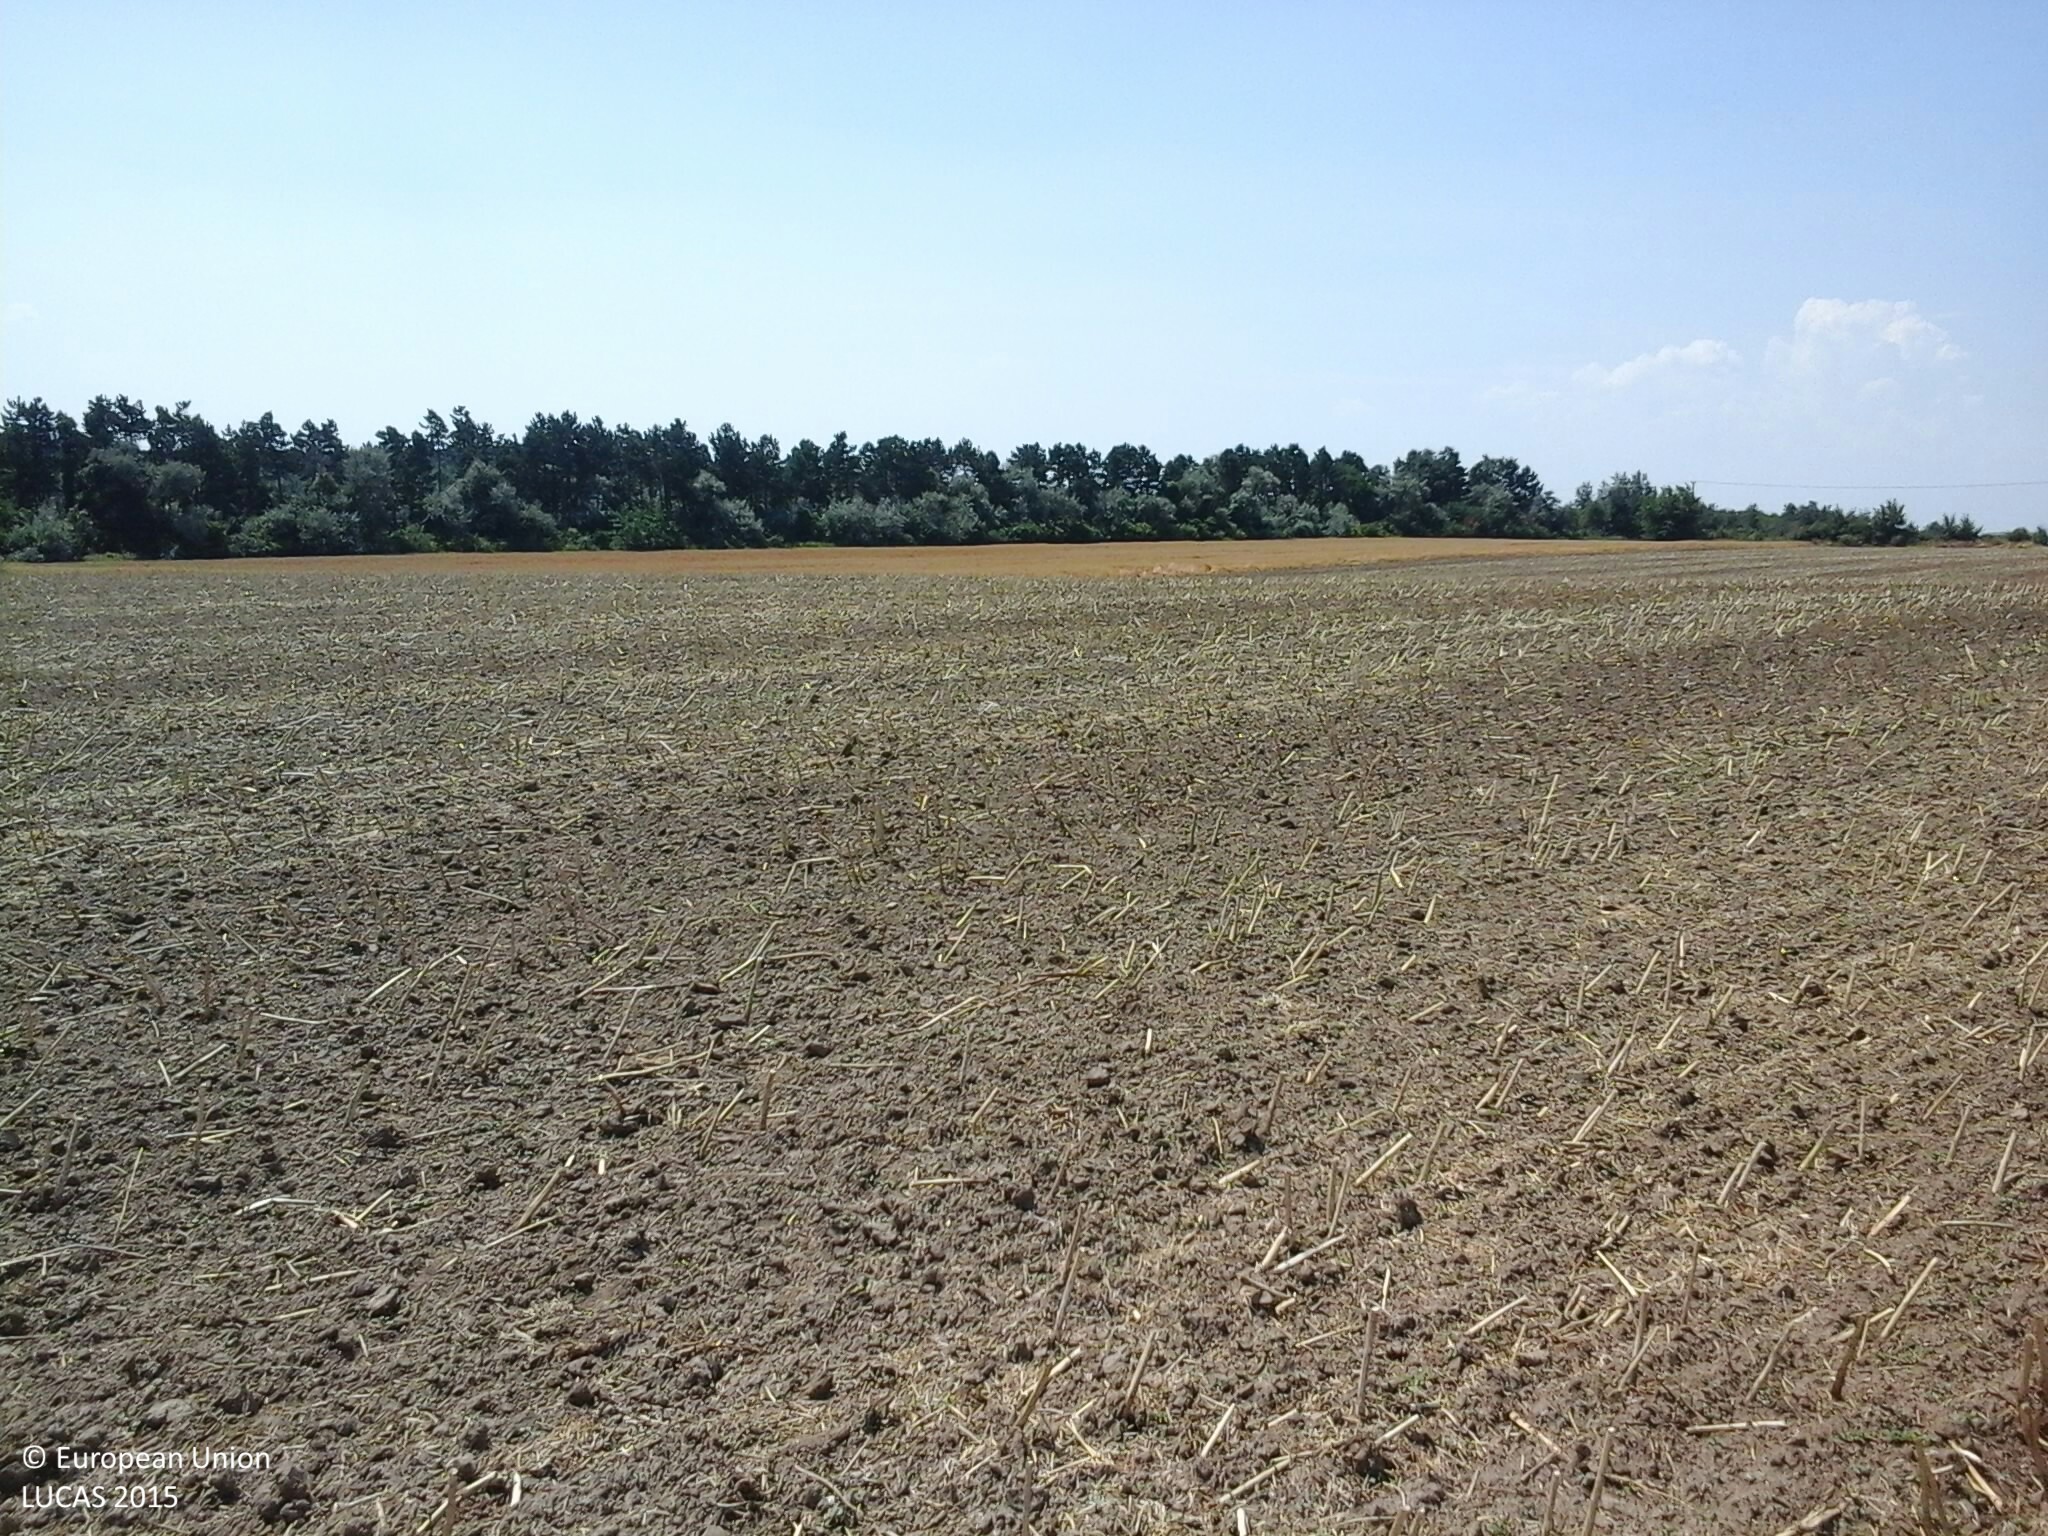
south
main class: Cropland
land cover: Rape and turnip rape
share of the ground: 10 - 25 %
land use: Agriculture (excluding fallow land and kitchen gardens)
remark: Harvested field
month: July
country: HU
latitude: 47.3306
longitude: 18.3090
